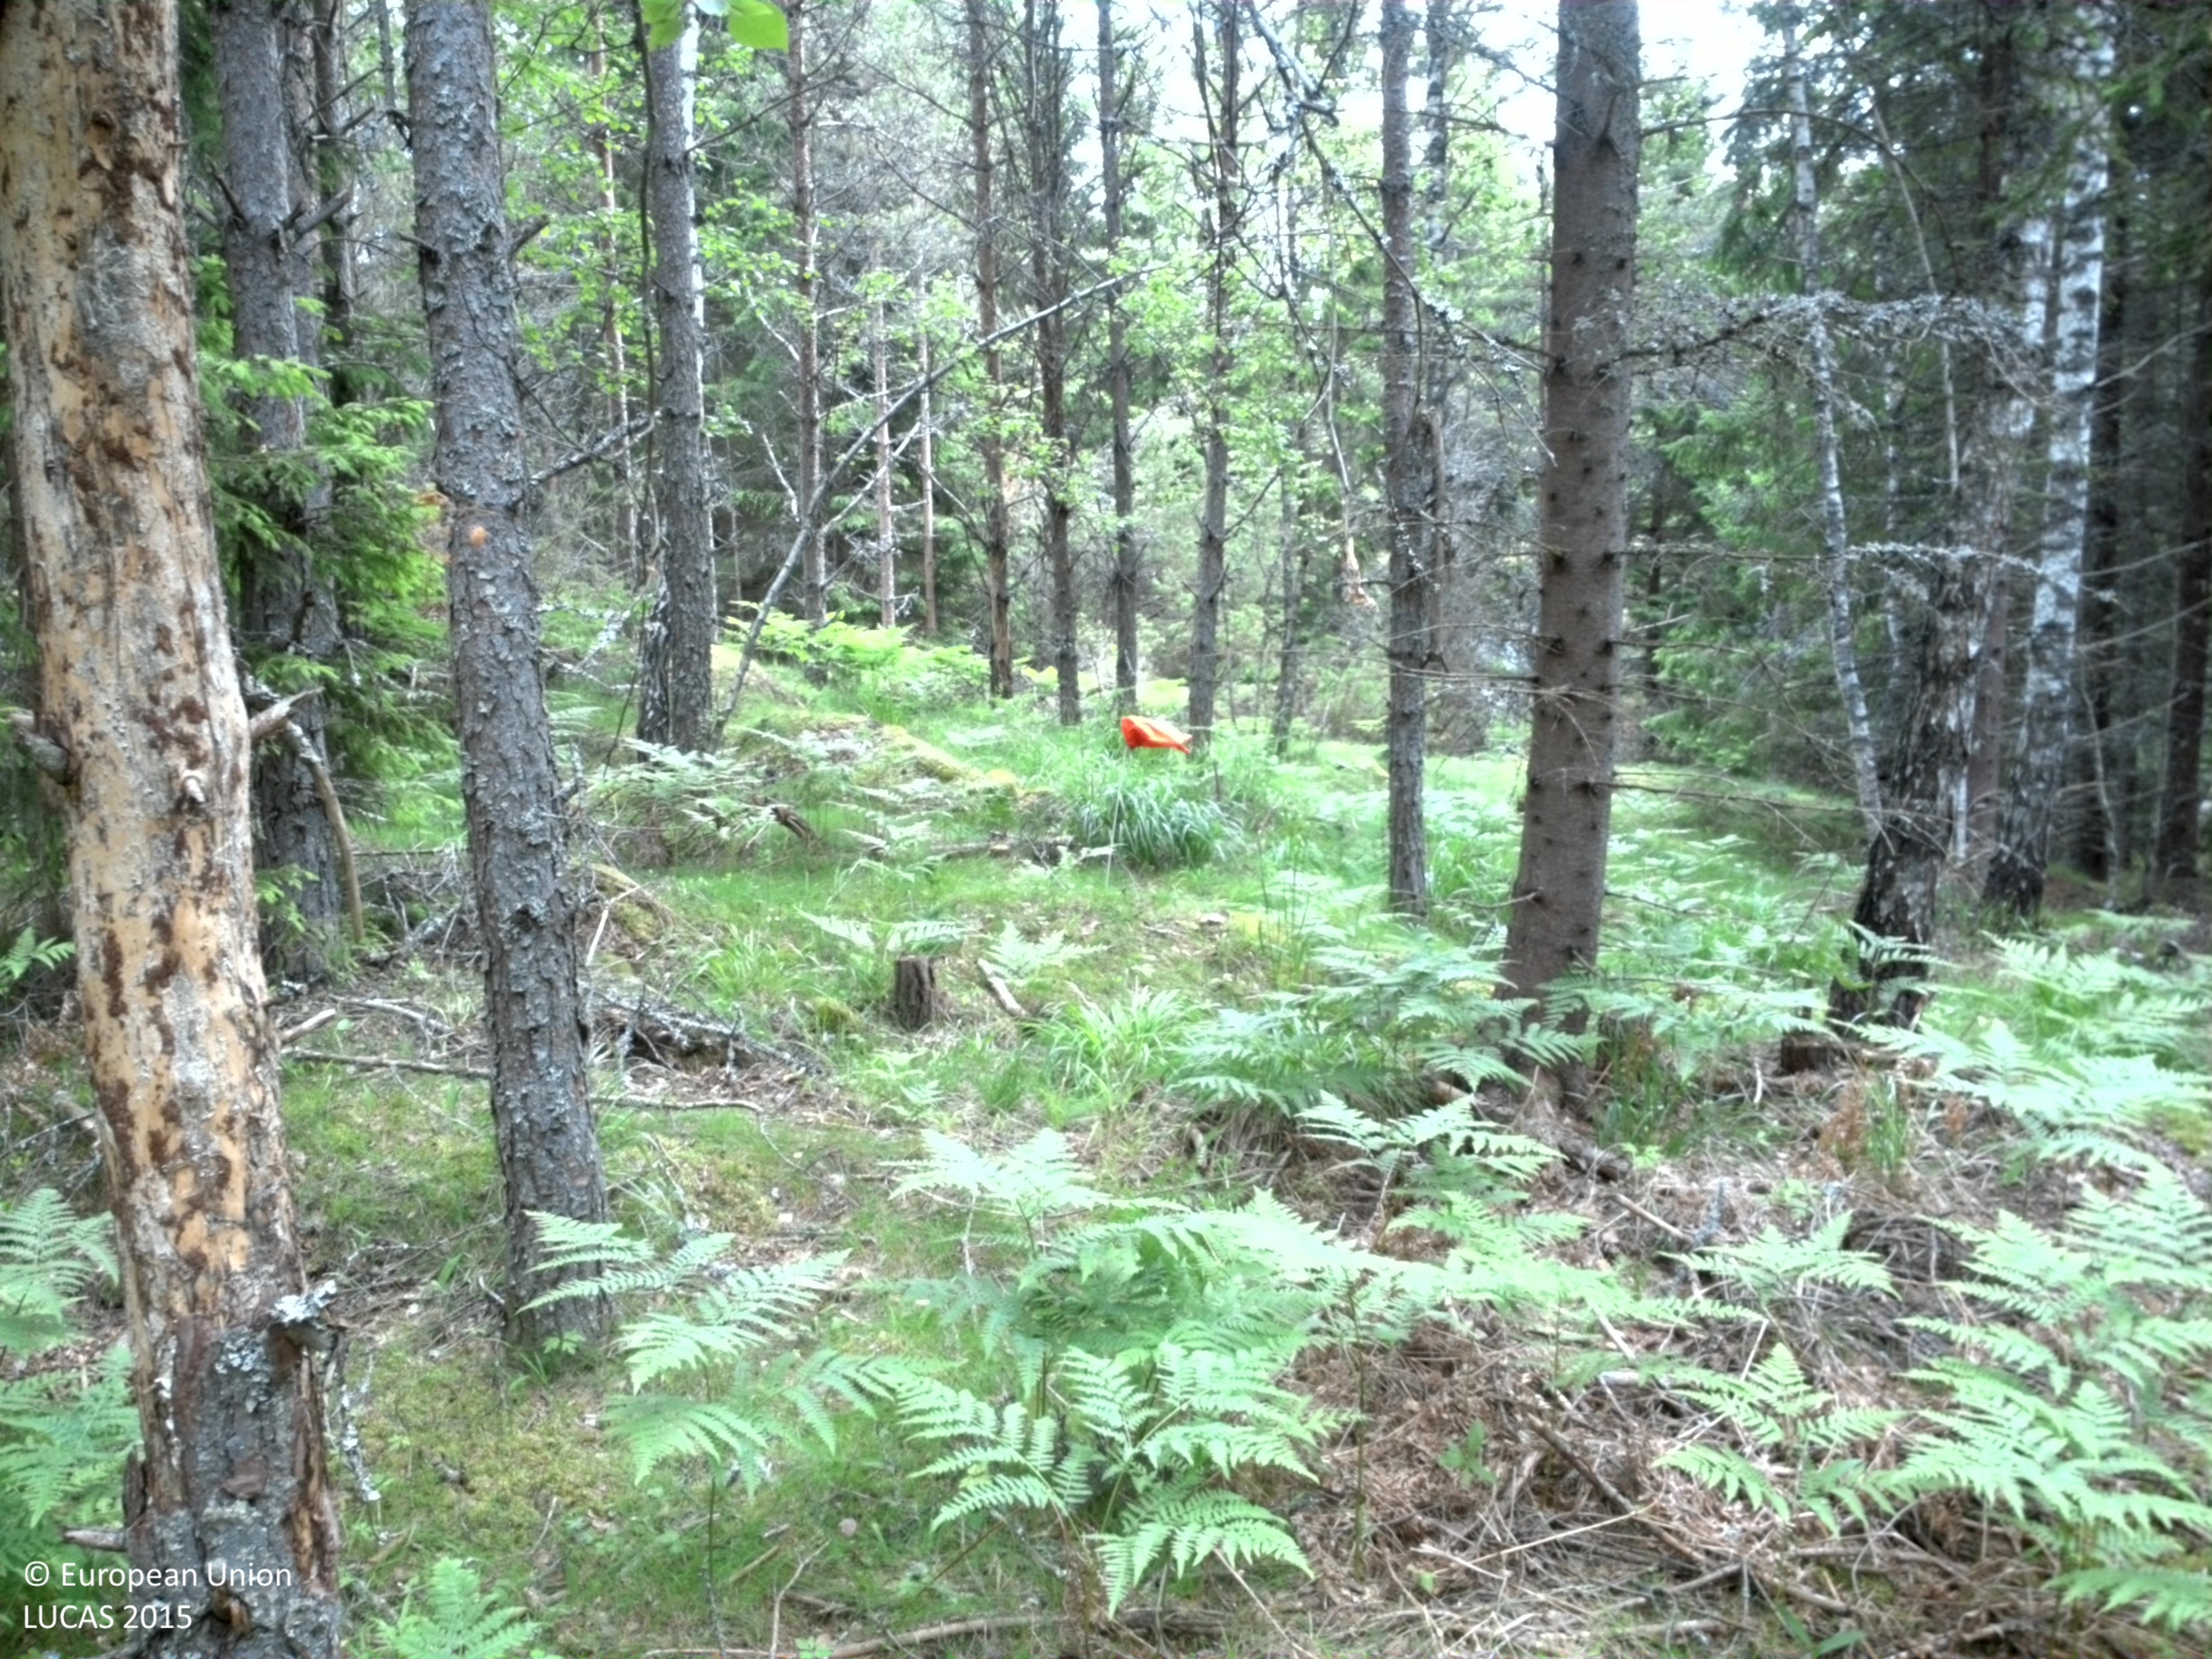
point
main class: Woodland
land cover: Pine dominated mixed woodland
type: boreal forest
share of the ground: 25 - 50 %
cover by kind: herbaceous plants 45 %, coniferous forest trees 25 %, lichens and mosses 20 %, broadleaved forest trees 10 %
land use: Forestry
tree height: > 5 m
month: June
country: SE
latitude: 58.6291
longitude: 15.5222
